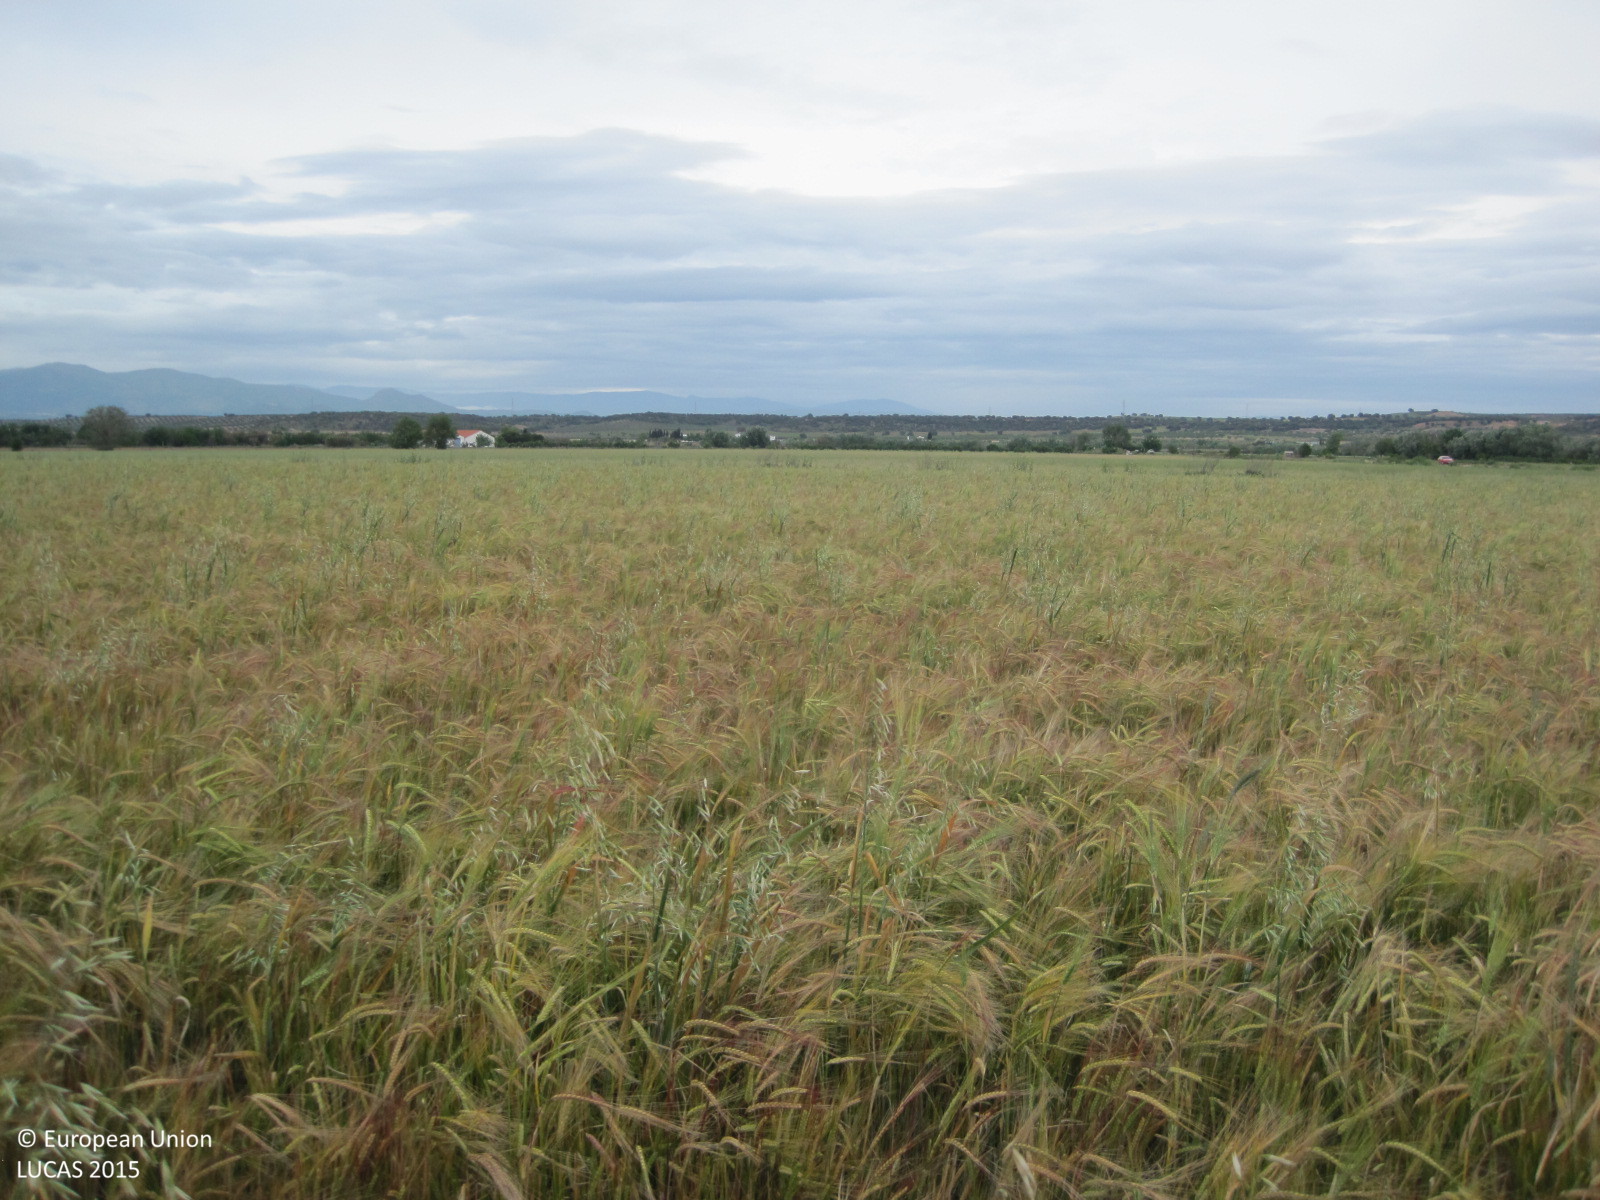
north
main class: Cropland
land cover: Mixed cereals for fodder
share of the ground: > 75 %
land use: Agriculture (excluding fallow land and kitchen gardens)
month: May
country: ES
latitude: 39.9481
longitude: -4.6638
